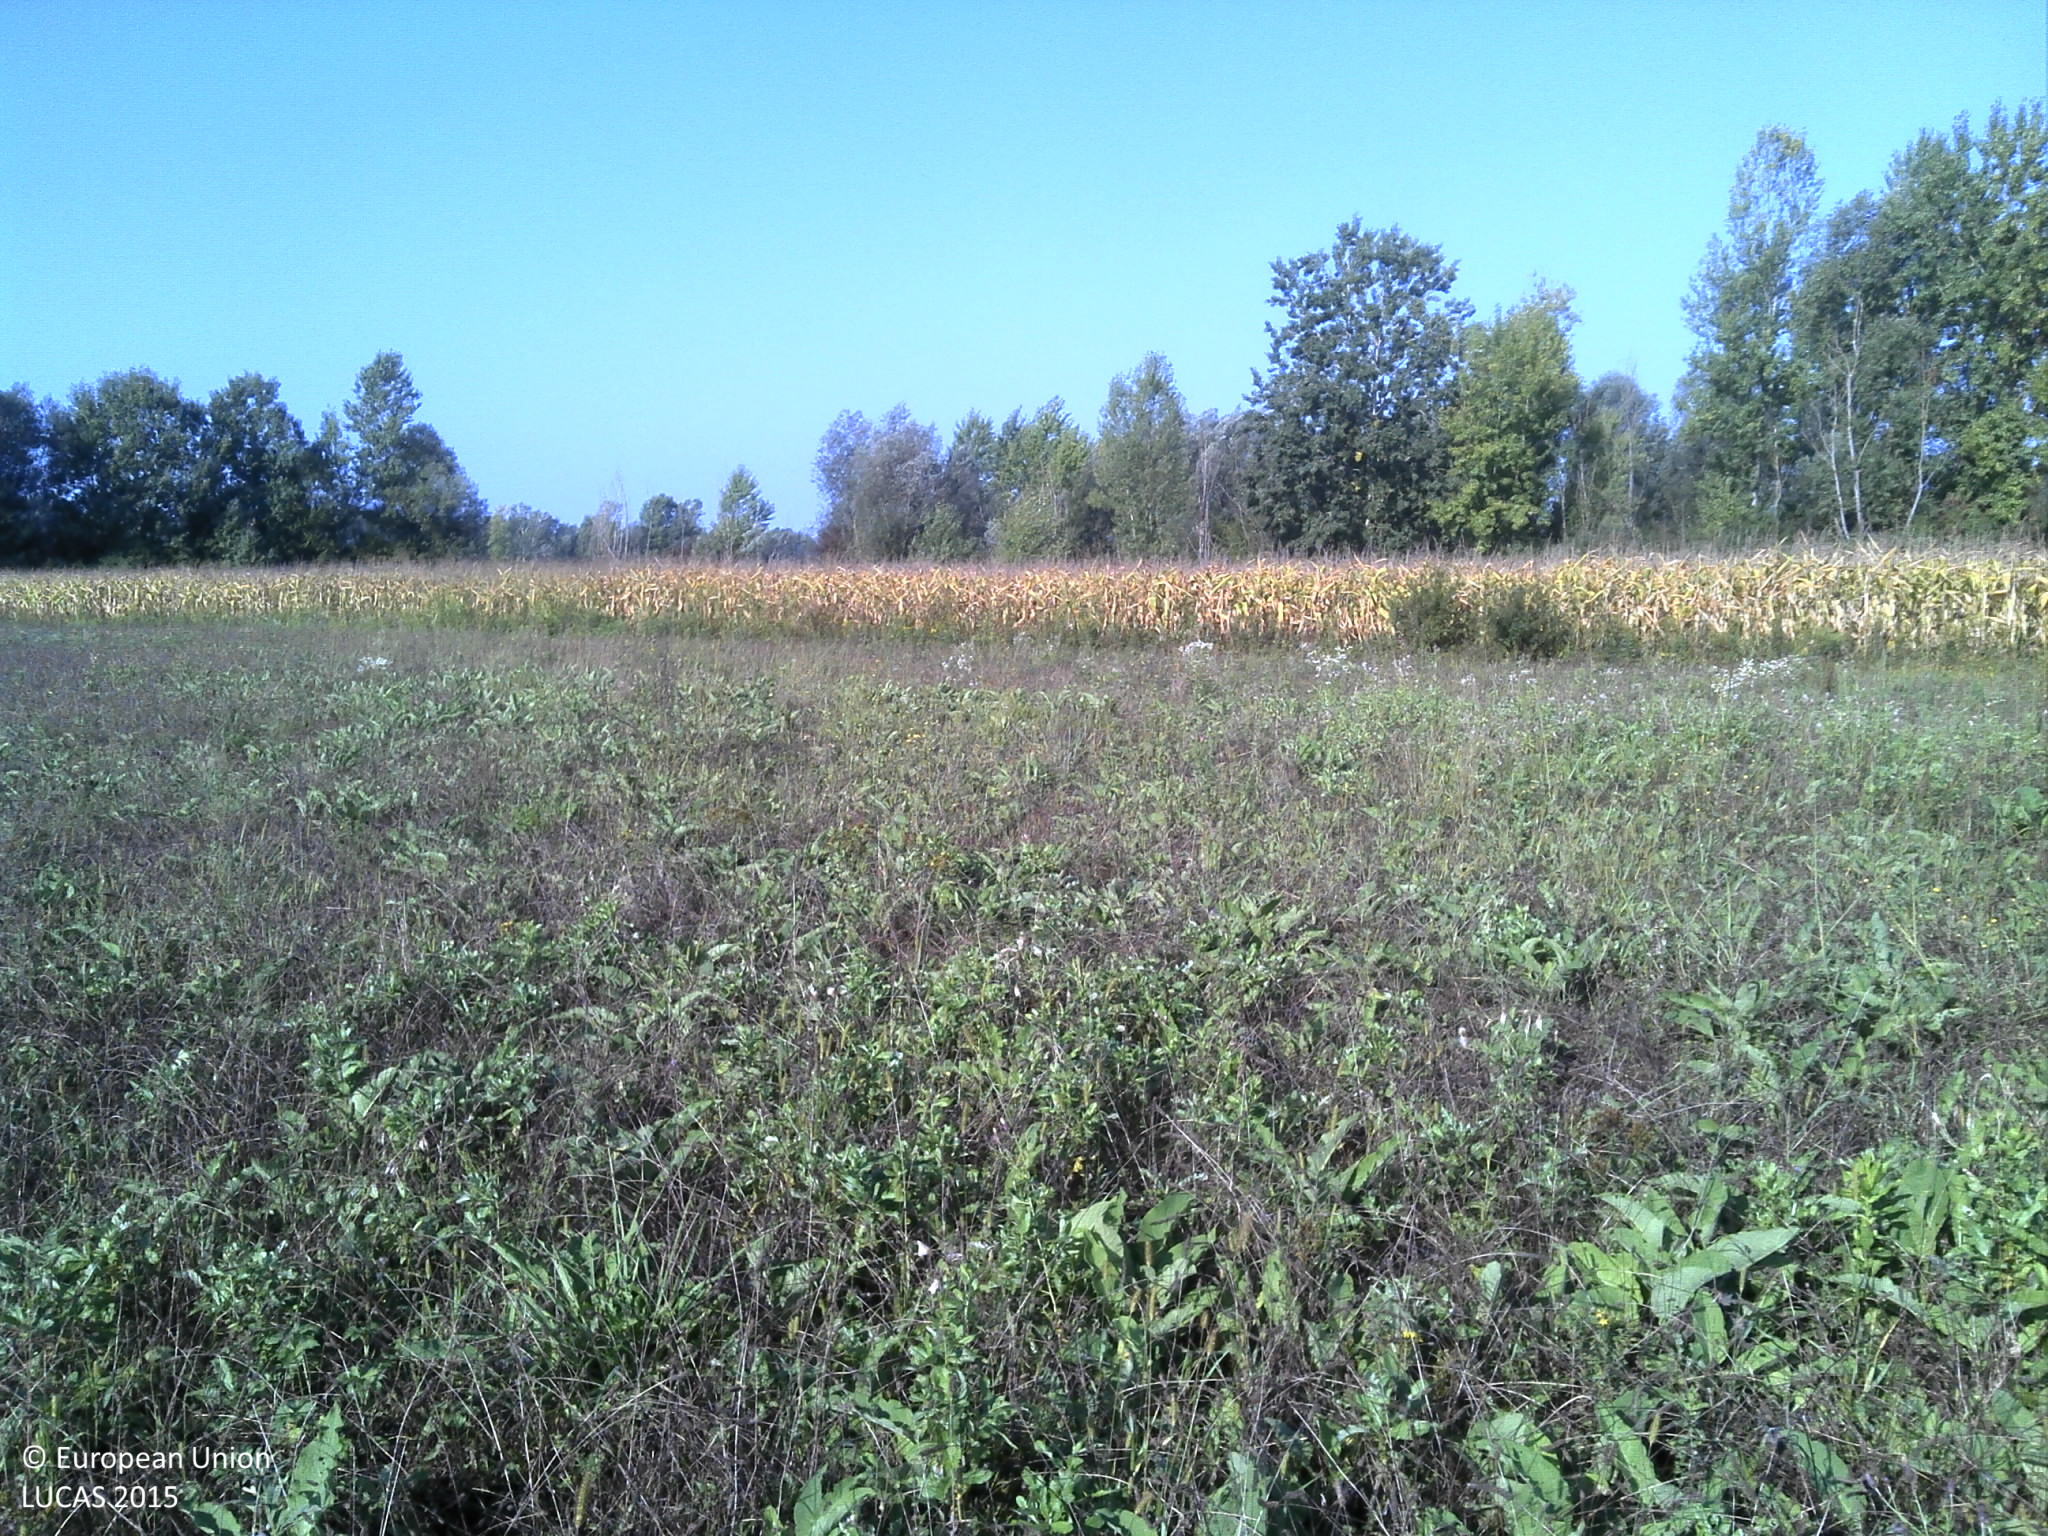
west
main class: Grassland
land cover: Grassland without tree/shrub cover
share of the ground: > 75 %
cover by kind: herbaceous plants 100 %
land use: Agriculture (excluding fallow land and kitchen gardens)
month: September
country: HR
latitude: 45.5817
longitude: 16.3935
